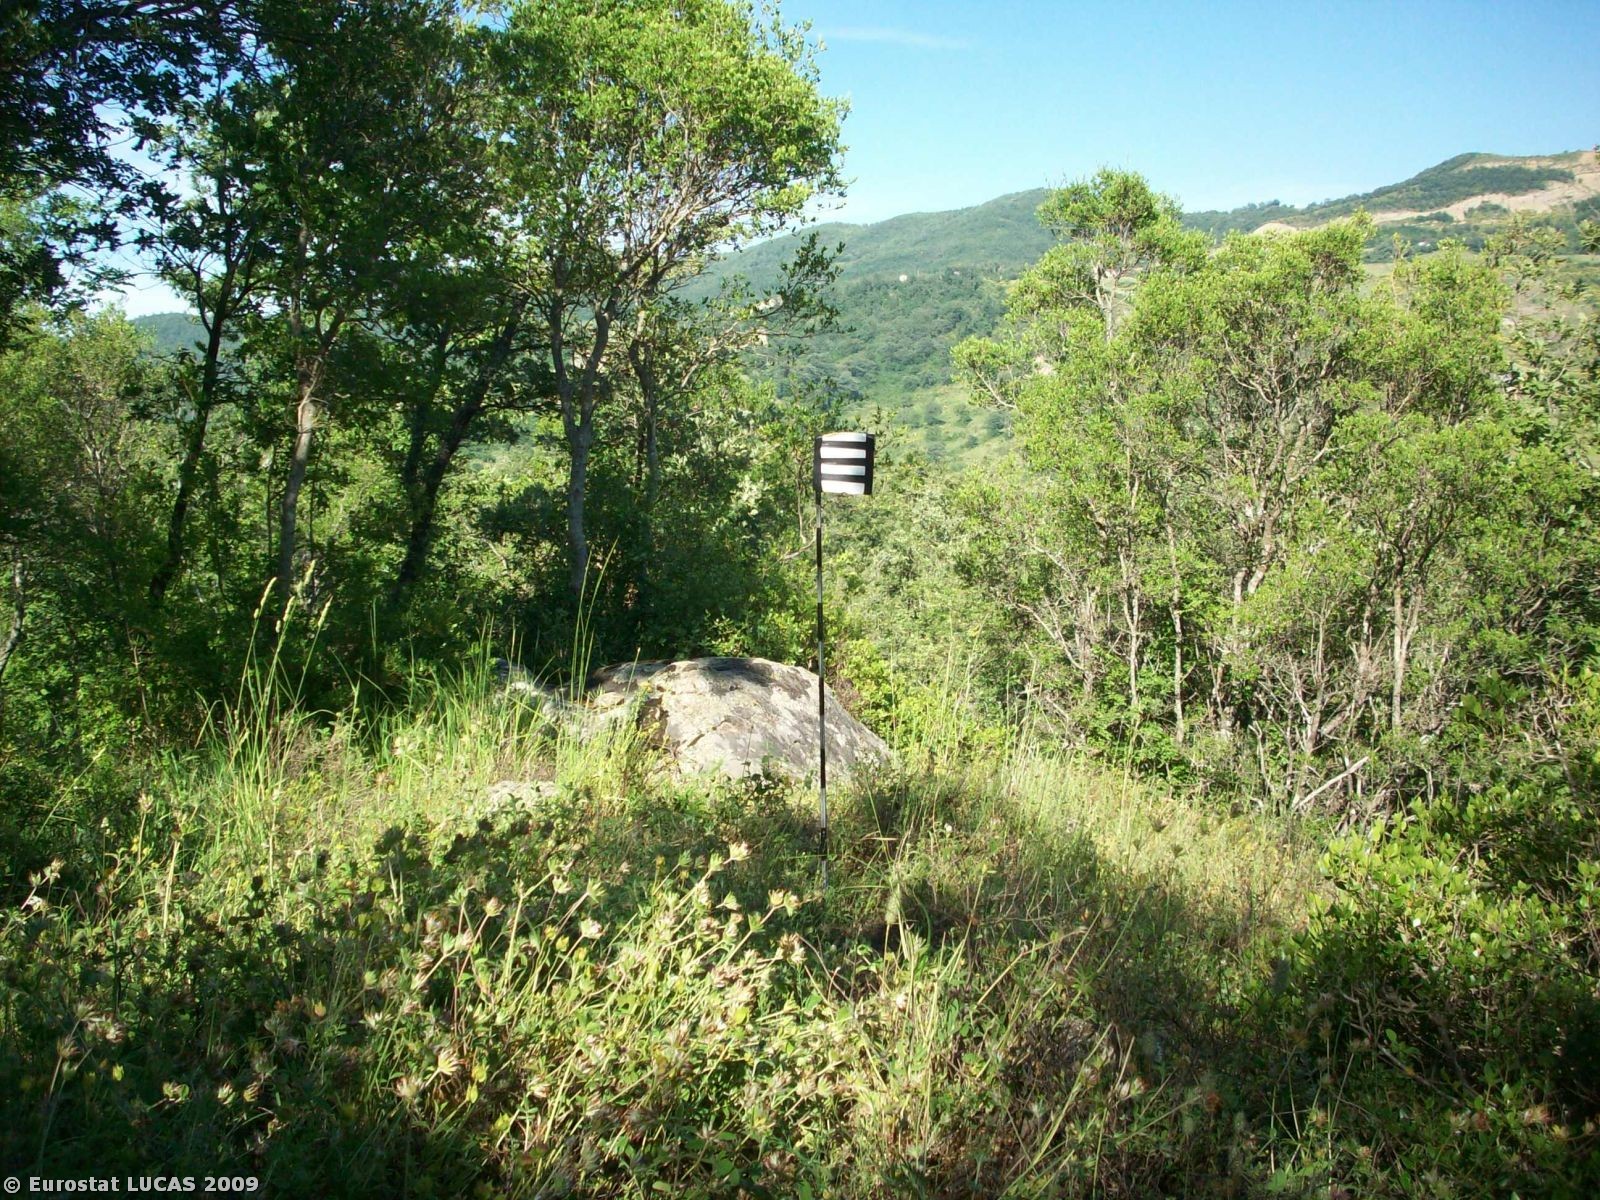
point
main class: Woodland
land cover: Broadleaved woodland
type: broadleaved evergreen forest
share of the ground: > 75 %
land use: Nature reserves
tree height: > 5 m
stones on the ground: 10 - 25 %
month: June
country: IT
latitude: 40.0501
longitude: 16.2450
